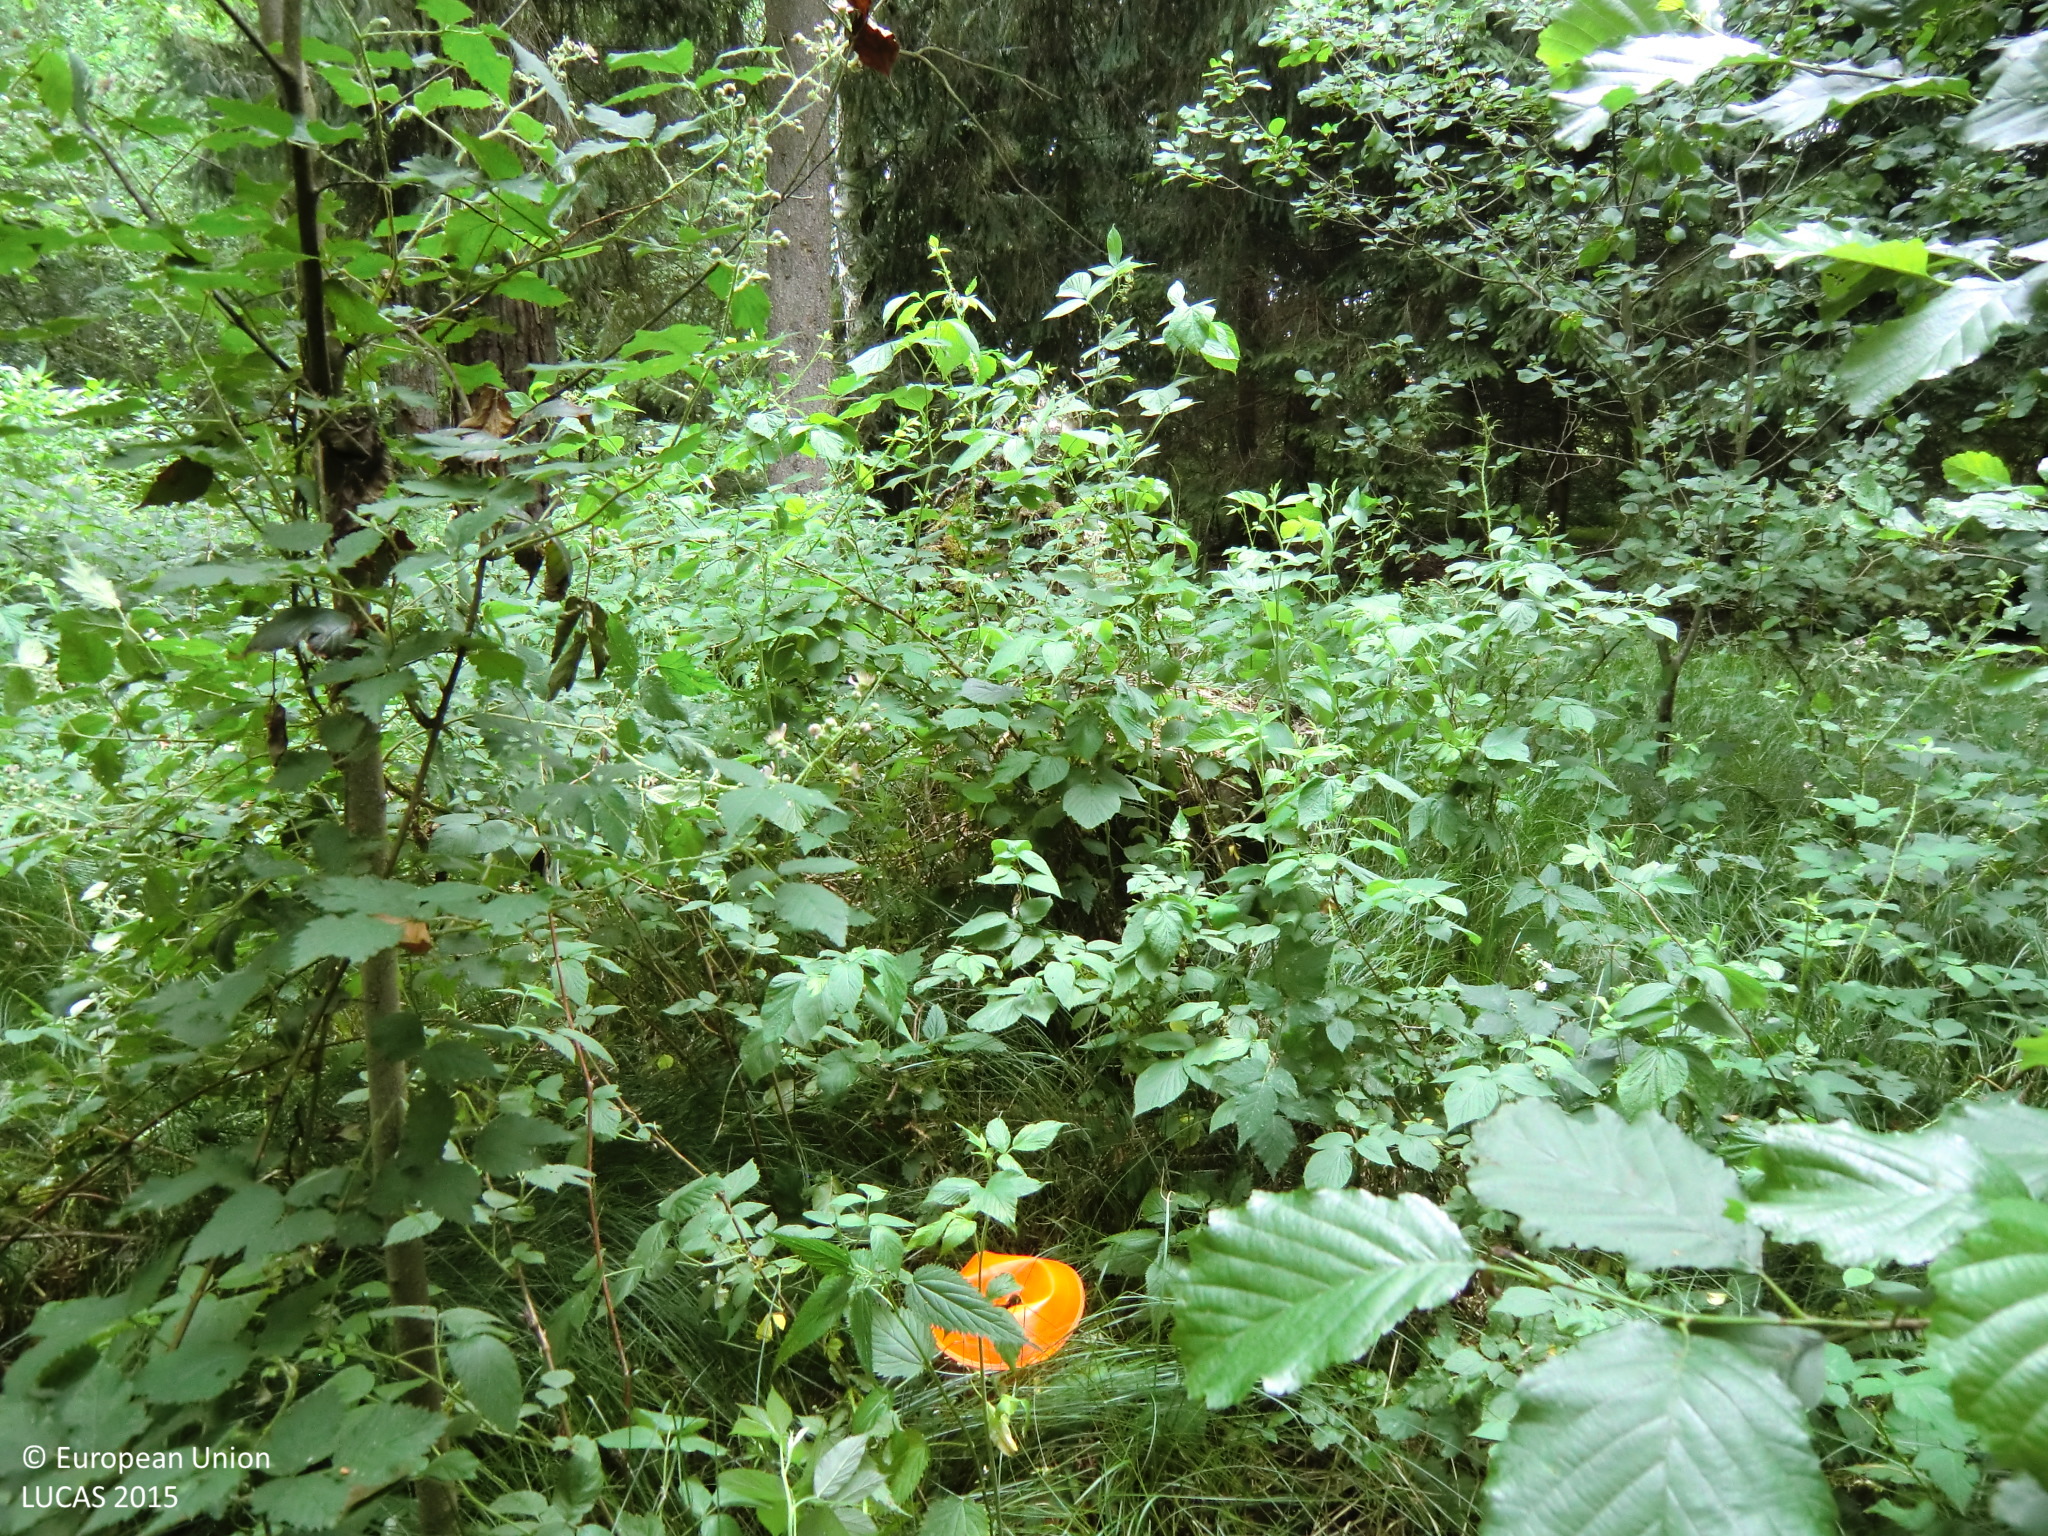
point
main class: Woodland
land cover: Spruce dominated mixed woodland
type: hemiboreal forest and nemoral coniferous forest and mixed broadleaved-coniferous forest
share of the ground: > 75 %
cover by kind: coniferous forest trees 35 %, broadleaved forest trees 30 %, herbaceous plants 15 %, shrubs 10 %, unconsolidated bare surface 10 %
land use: Forestry
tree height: > 5 m
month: June
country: AT
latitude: 47.2443
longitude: 16.0658
